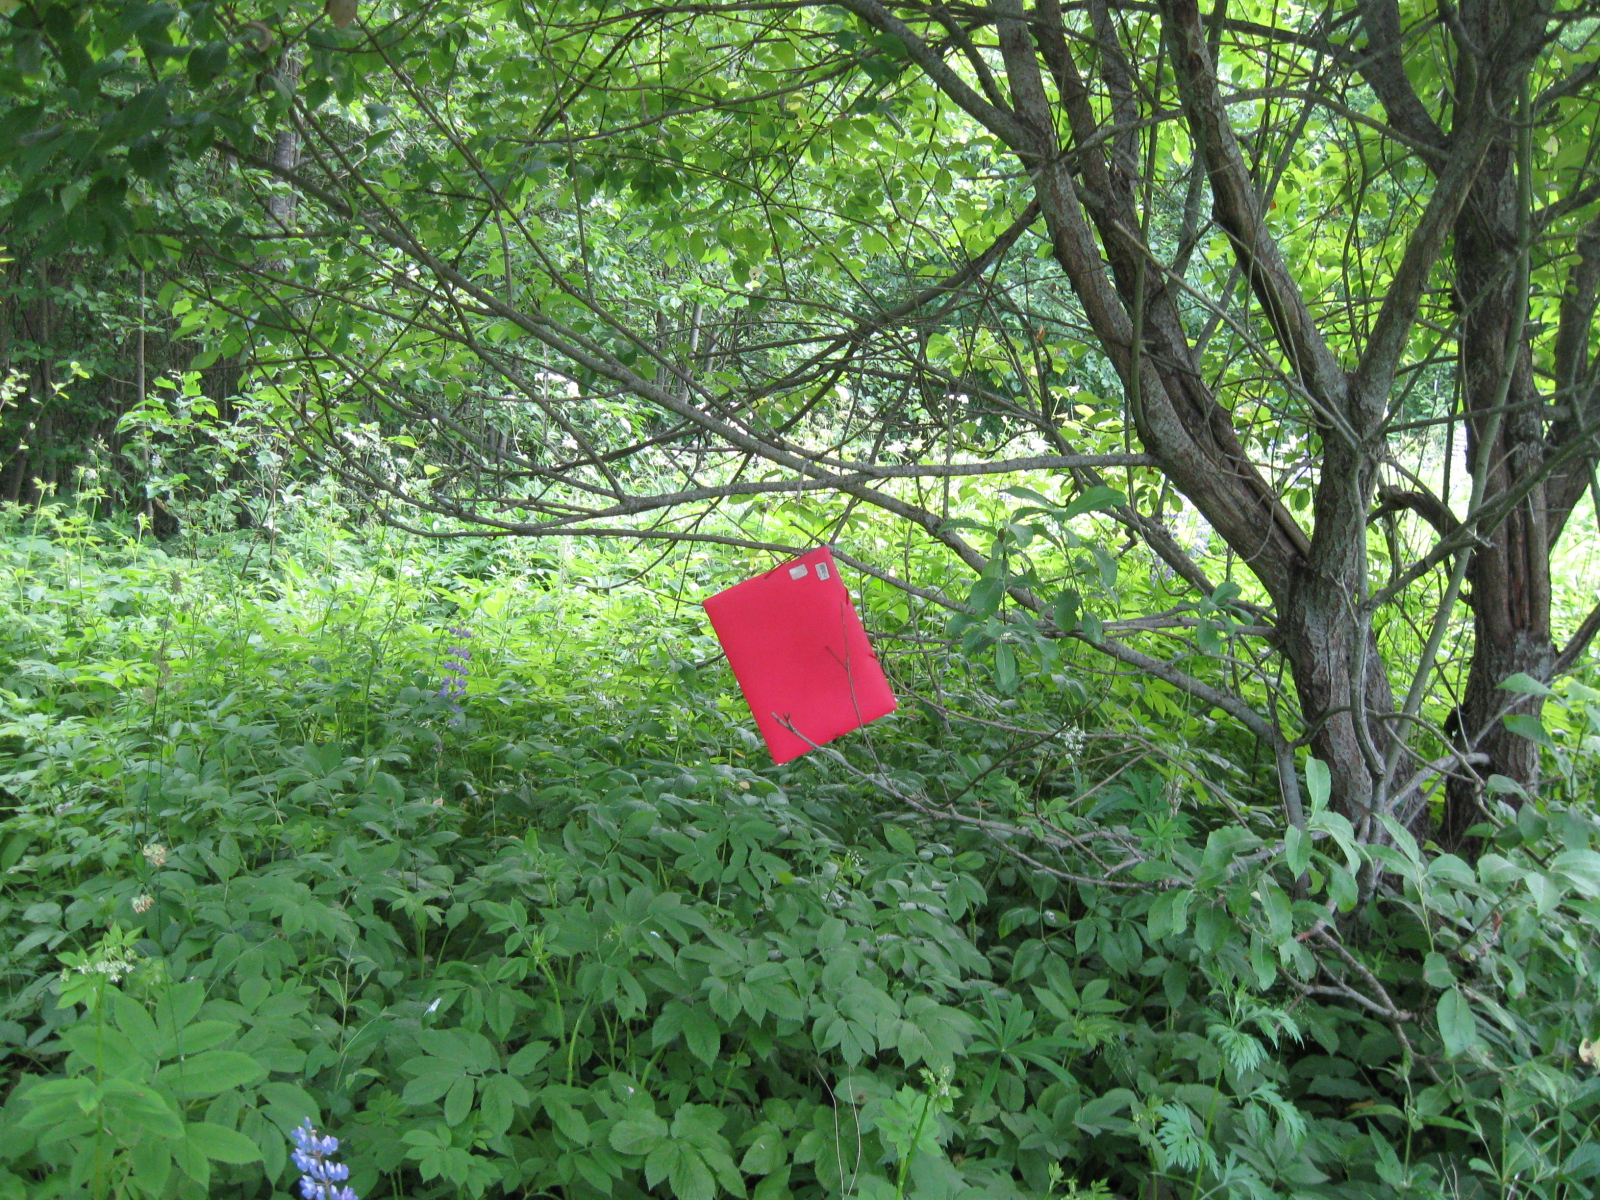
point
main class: Woodland
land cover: Broadleaved woodland
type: floodplain forest
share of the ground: 50 - 75 %
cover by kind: broadleaved forest trees 70 %, herbaceous plants 30 %
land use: Forestry
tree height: > 5 m
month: June
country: LT
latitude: 54.4334
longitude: 24.5810
